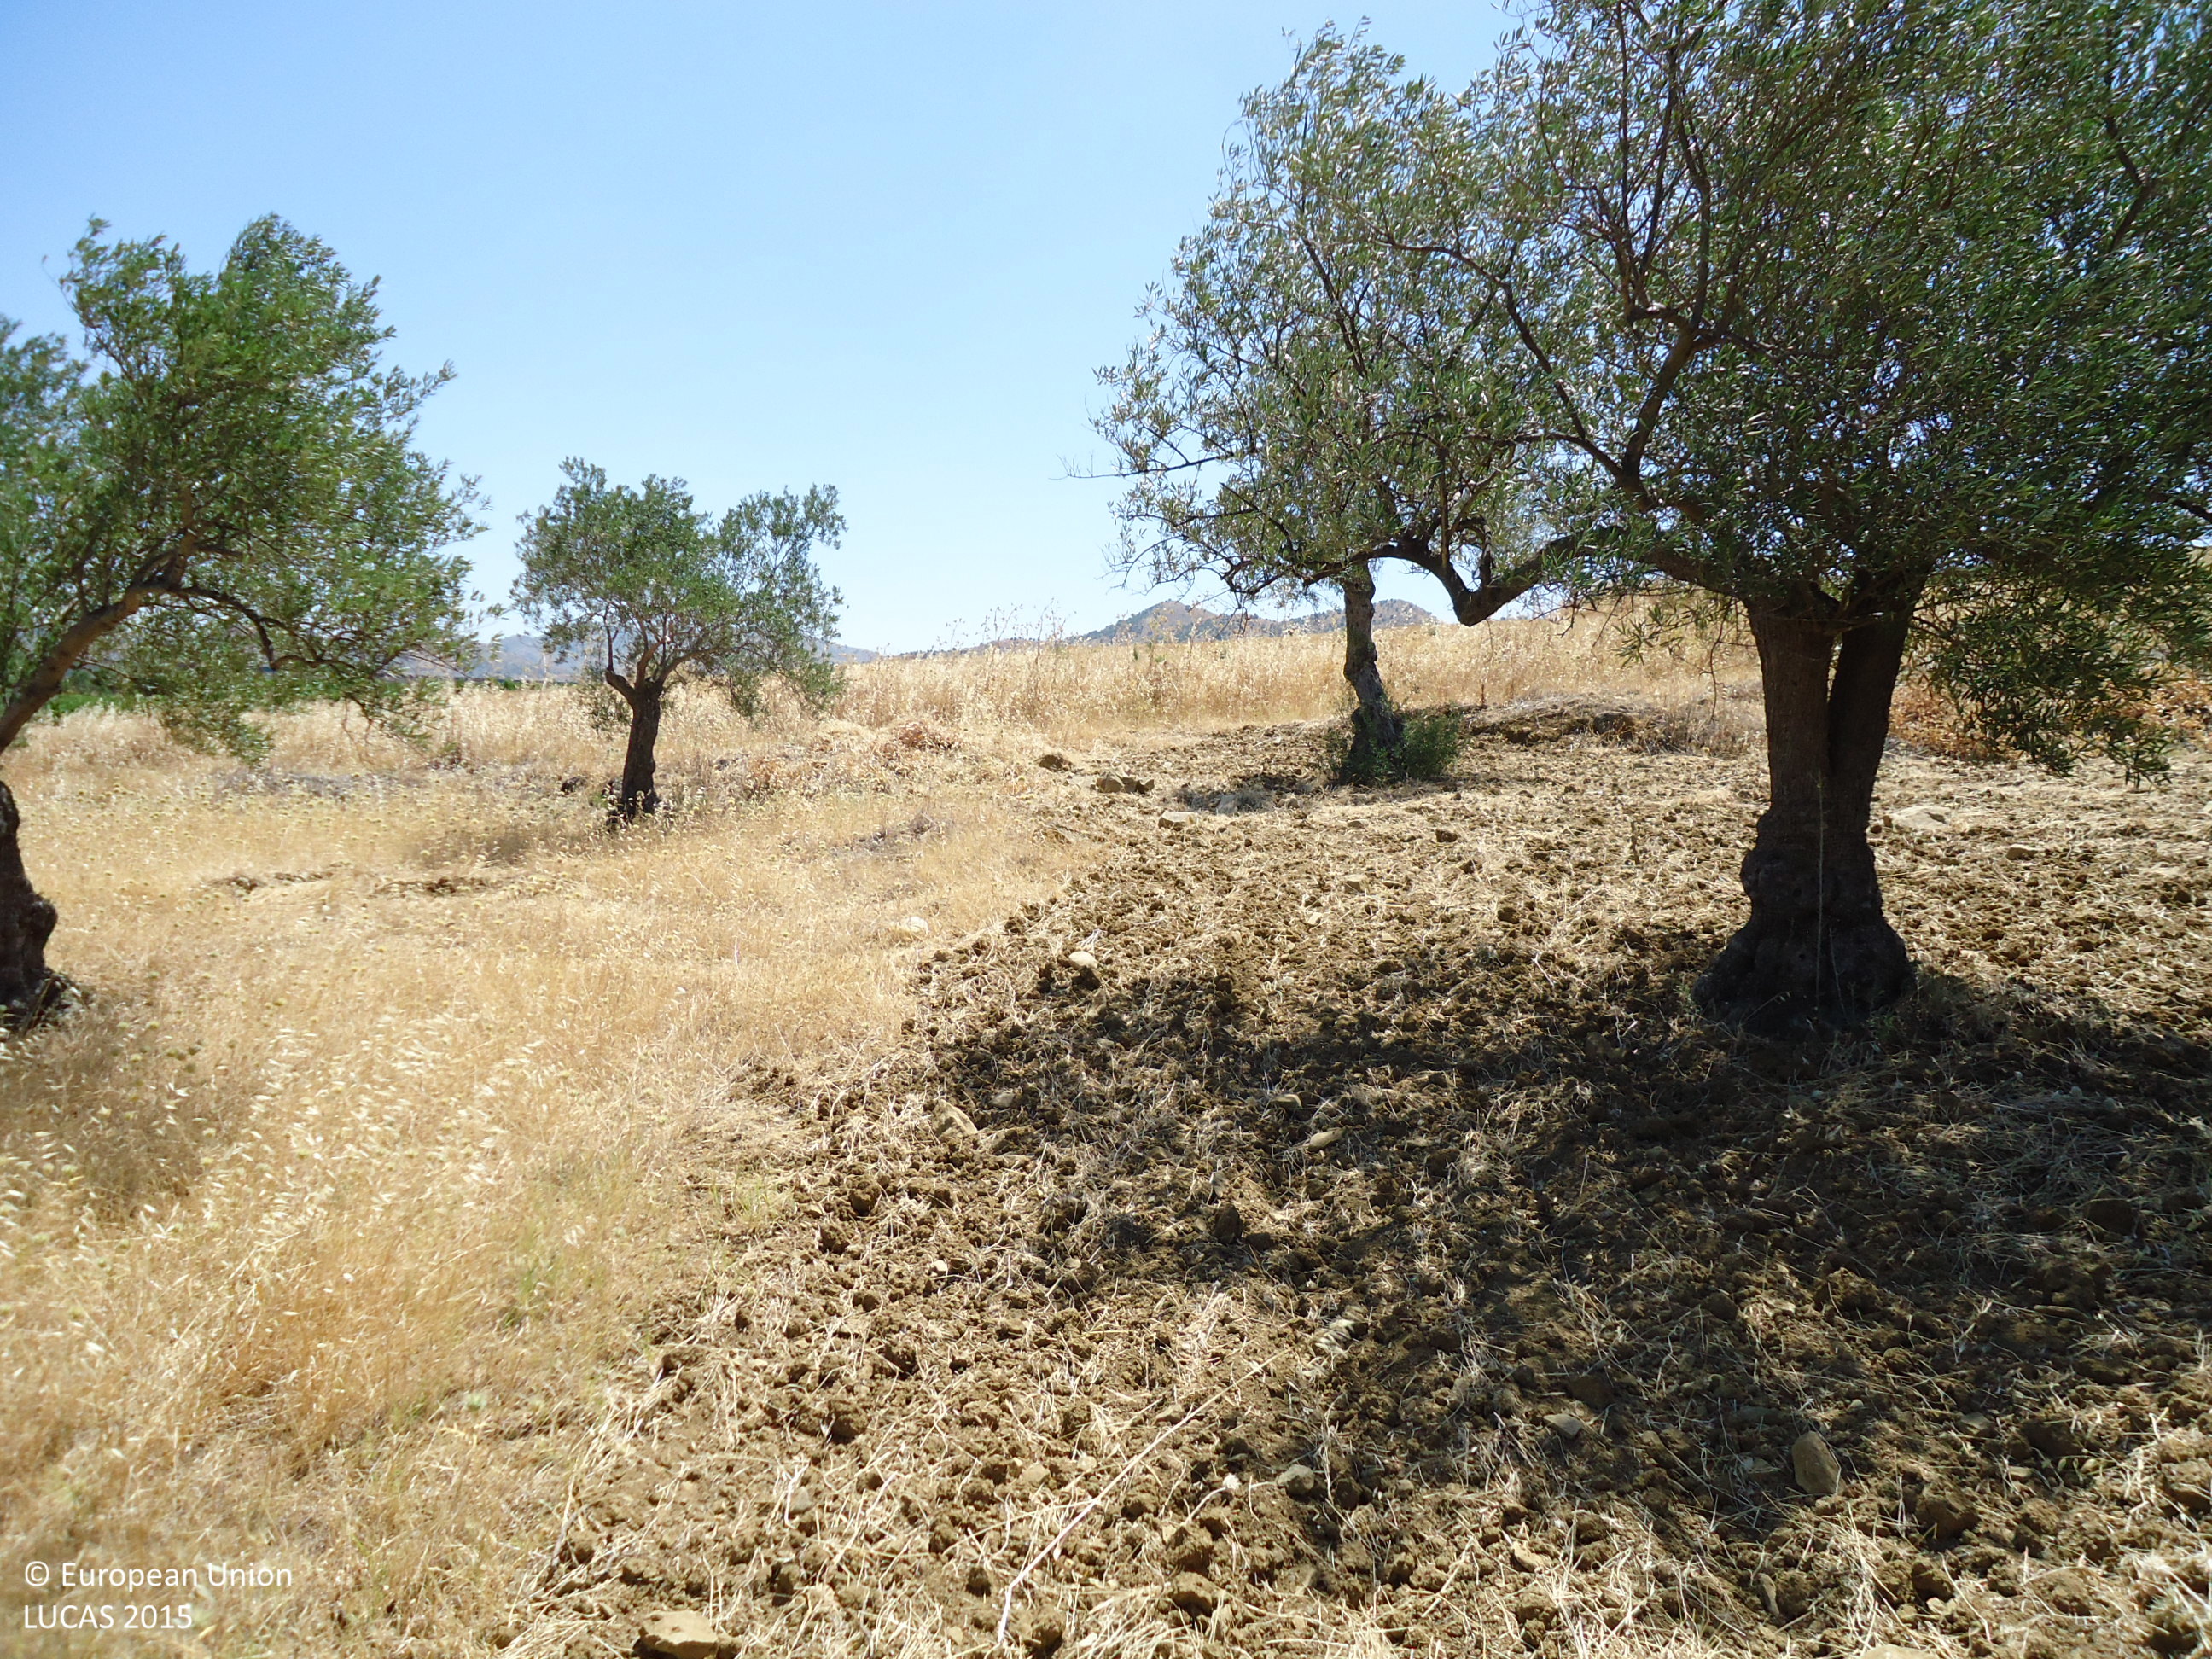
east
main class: Cropland
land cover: Olive groves
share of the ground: 25 - 50 %
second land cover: Other bare soil
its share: > 75 %
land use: Agriculture (excluding fallow land and kitchen gardens)
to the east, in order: Olive groves; Other bare soil; Tracks; Durum wheat; Tracks; Grassland without tree/shrub cover; Olive groves
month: June
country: ES
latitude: 36.8383
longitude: -4.6957
